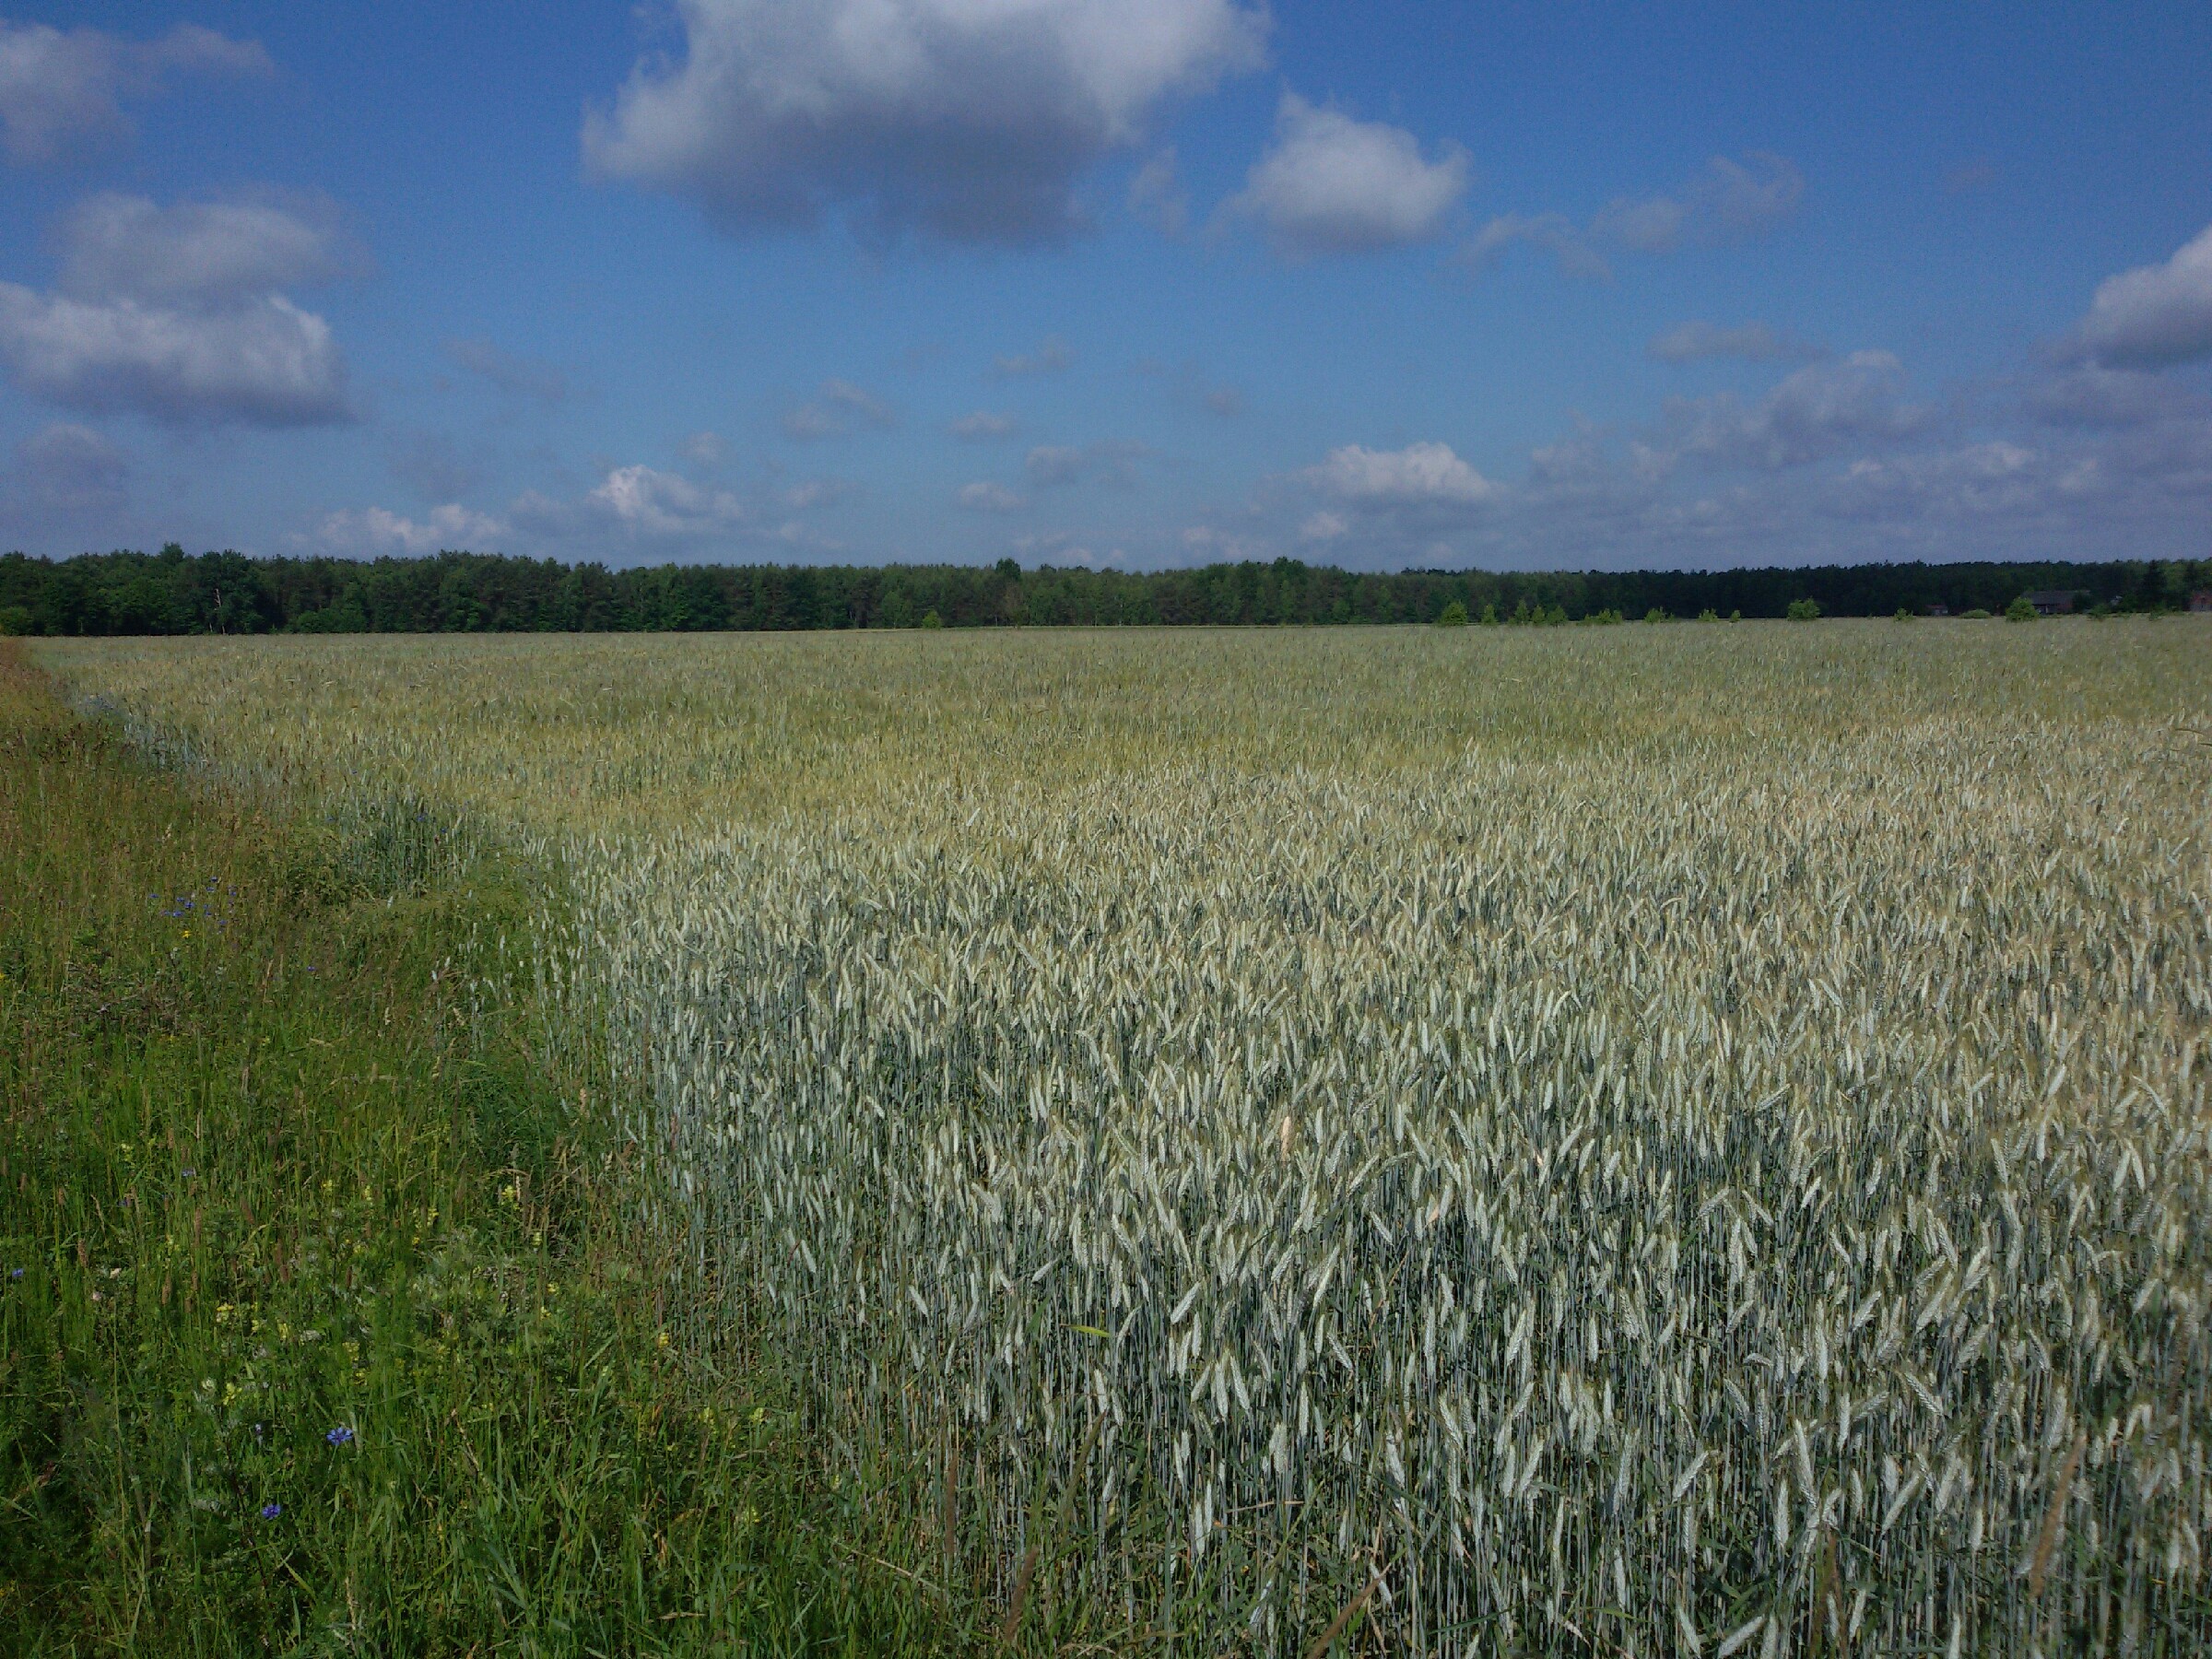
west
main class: Cropland
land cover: Rye
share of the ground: > 75 %
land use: Agriculture (excluding fallow land and kitchen gardens)
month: June
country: PL
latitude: 51.9219
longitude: 23.0905
